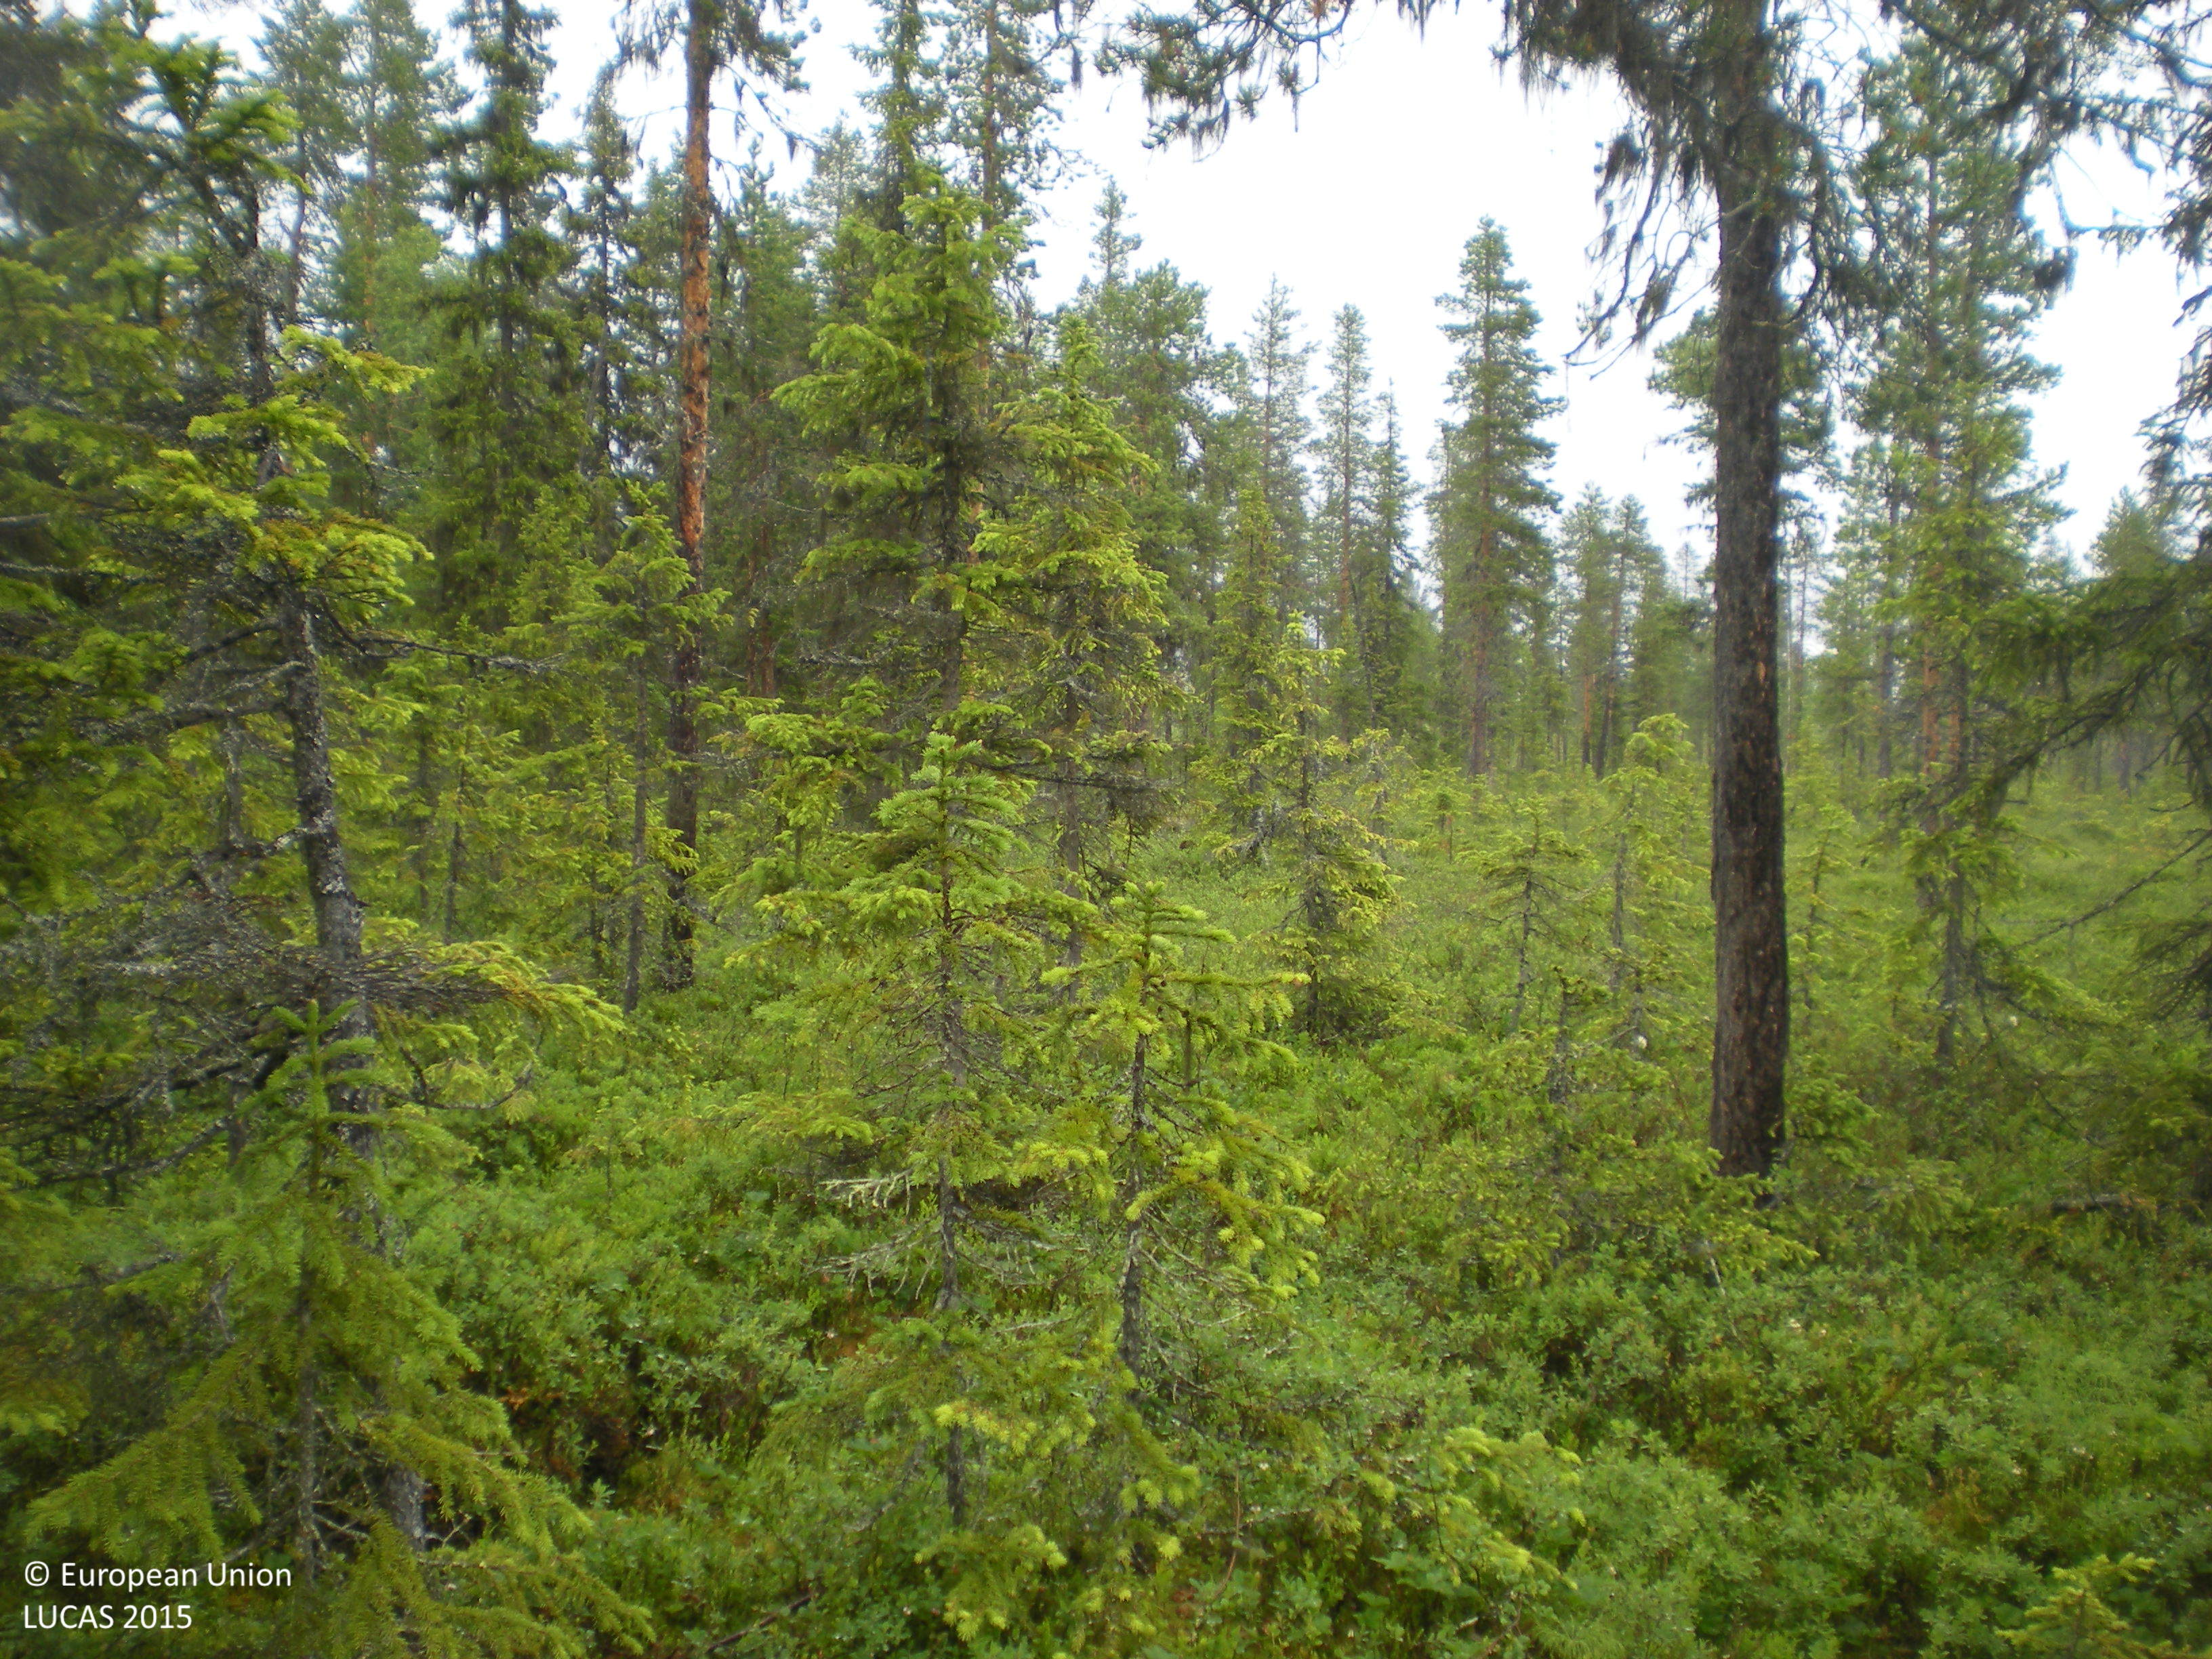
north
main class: Woodland
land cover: Other mixed woodland
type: boreal forest
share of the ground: 25 - 50 %
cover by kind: coniferous forest trees 35 %, shrubs 25 %, lichens and mosses 20 %, broadleaved forest trees 15 %, herbaceous plants 5 %
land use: Forestry
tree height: > 5 m
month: July
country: SE
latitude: 65.8070
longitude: 17.7642
